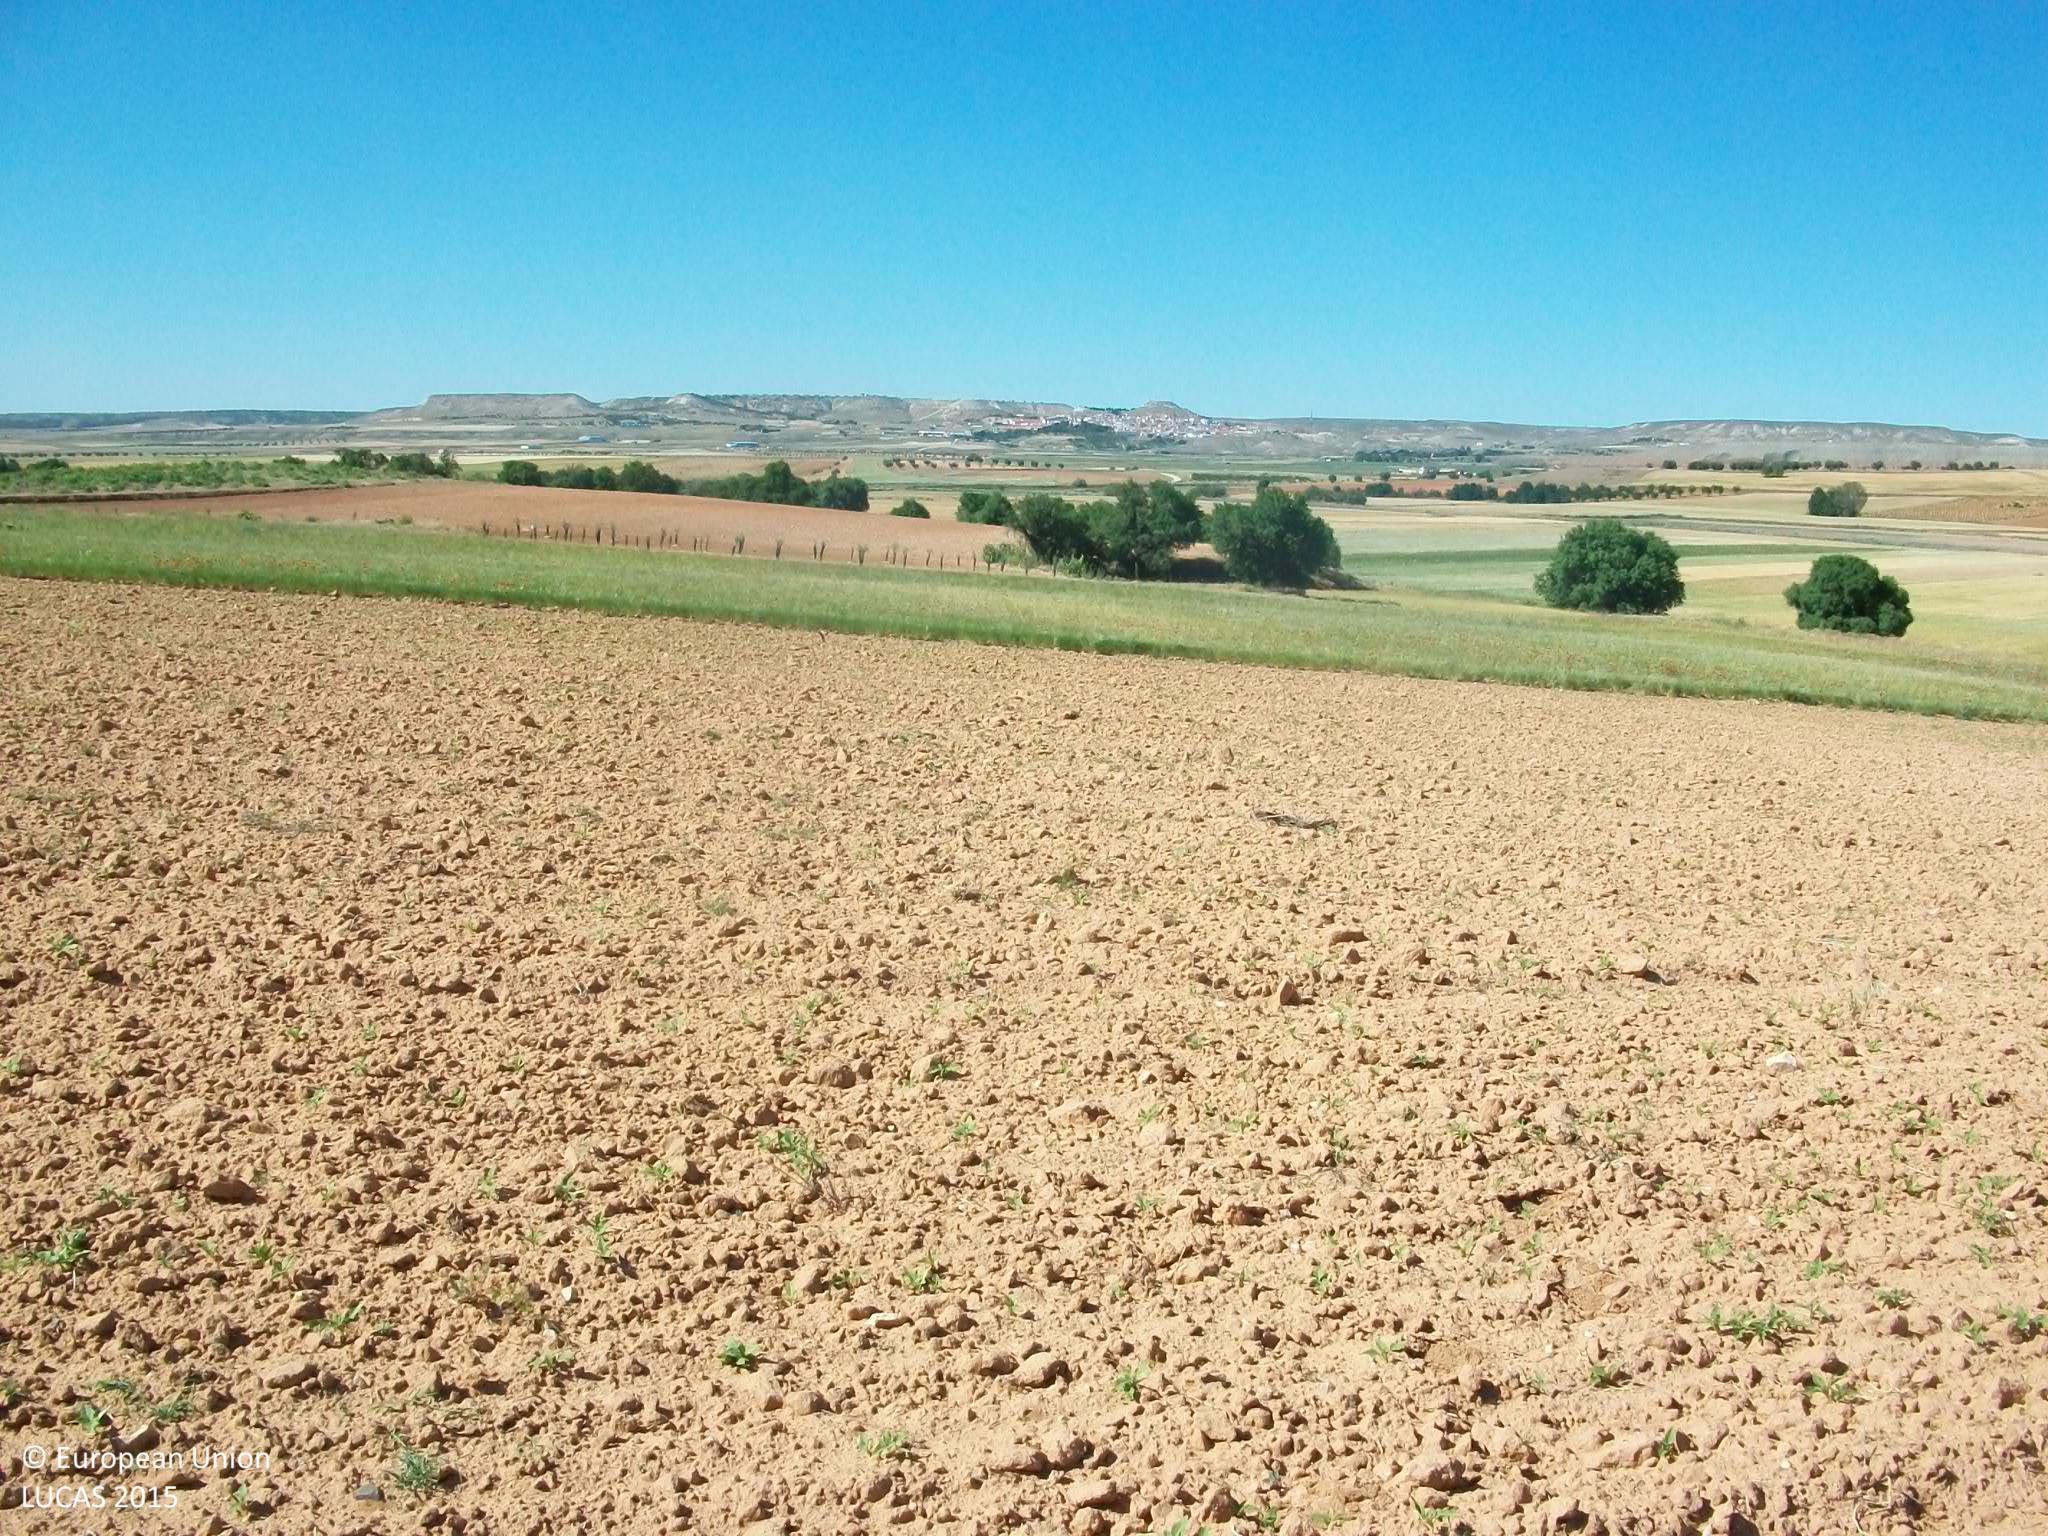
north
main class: Cropland
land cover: Dry pulses
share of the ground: < 10 %
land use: Agriculture (excluding fallow land and kitchen gardens)
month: May
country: ES
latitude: 39.8261
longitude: -3.6167
